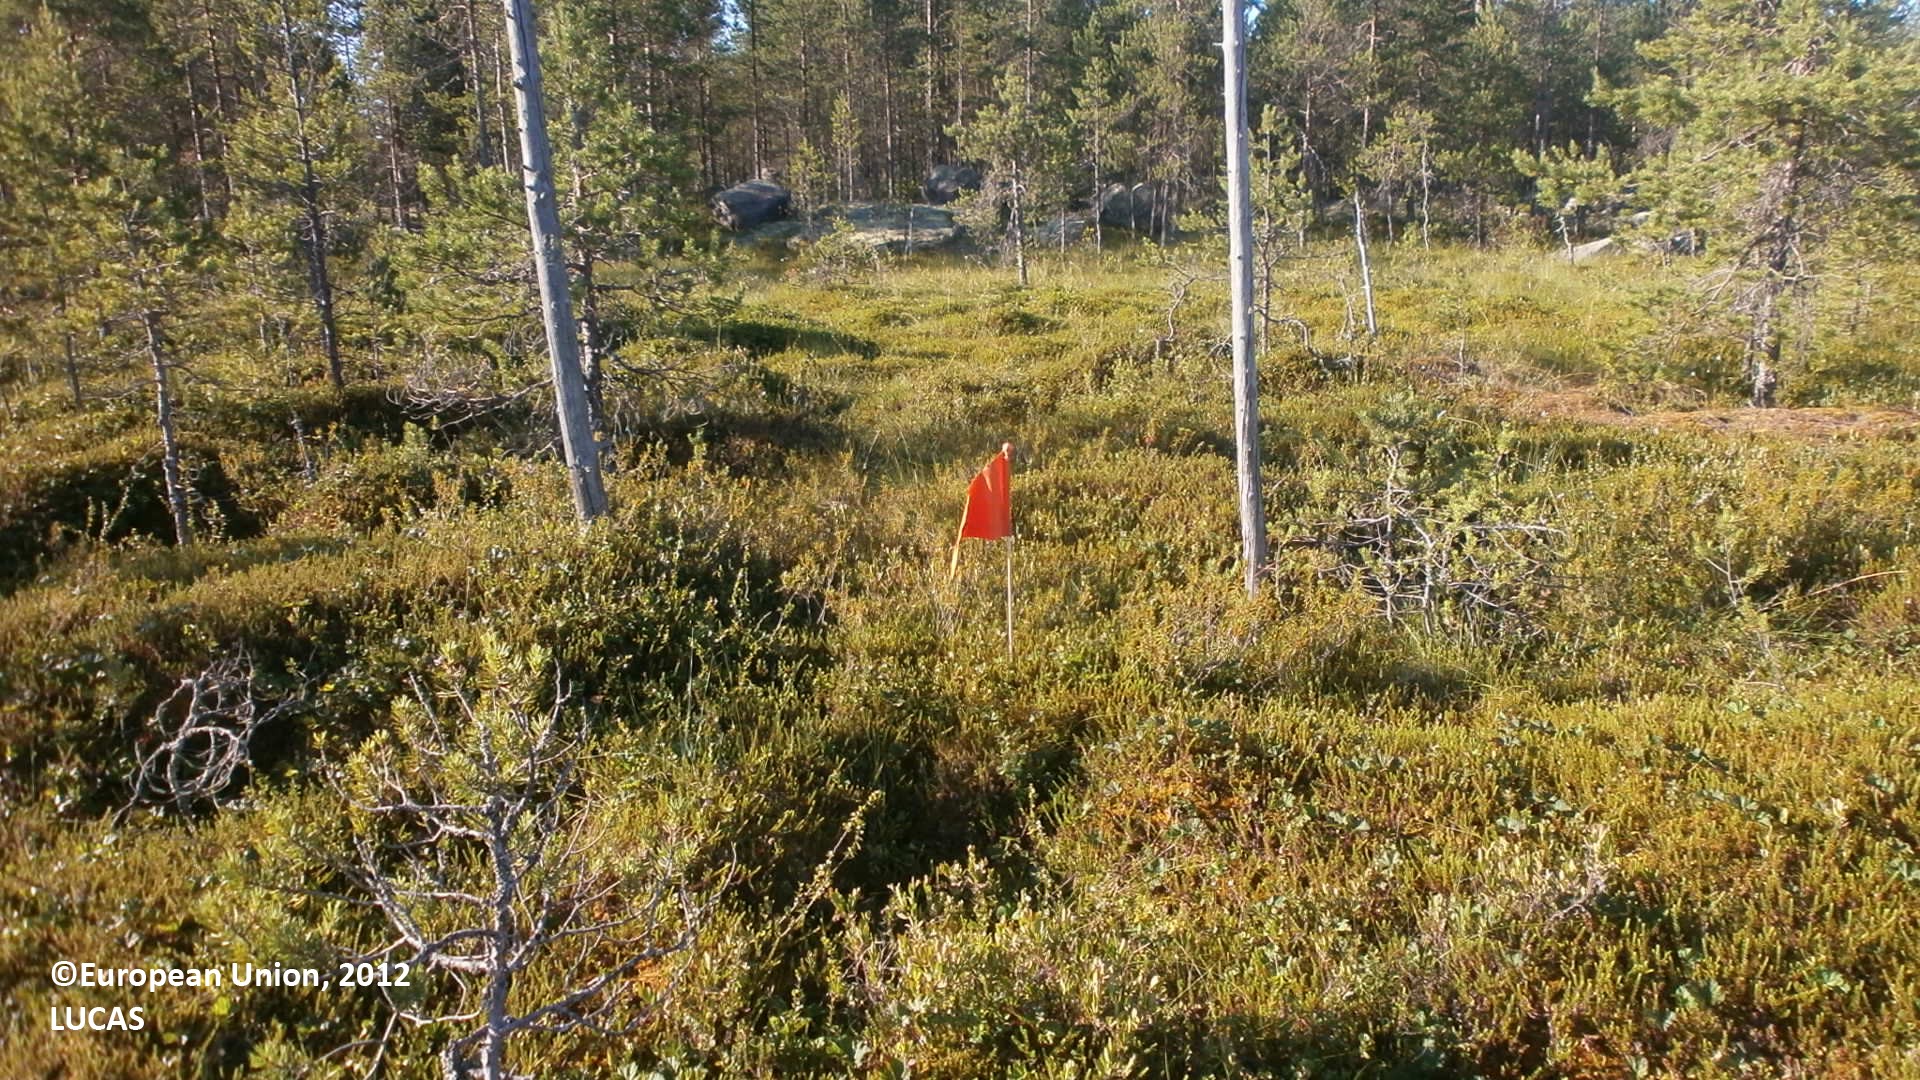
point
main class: Woodland
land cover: Pine dominated coniferous woodland
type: boreal forest
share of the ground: 10 - 25 %
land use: Semi-natural and natural areas not in use
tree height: < 5 m
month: July
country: FI
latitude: 64.0200
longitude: 24.1237
